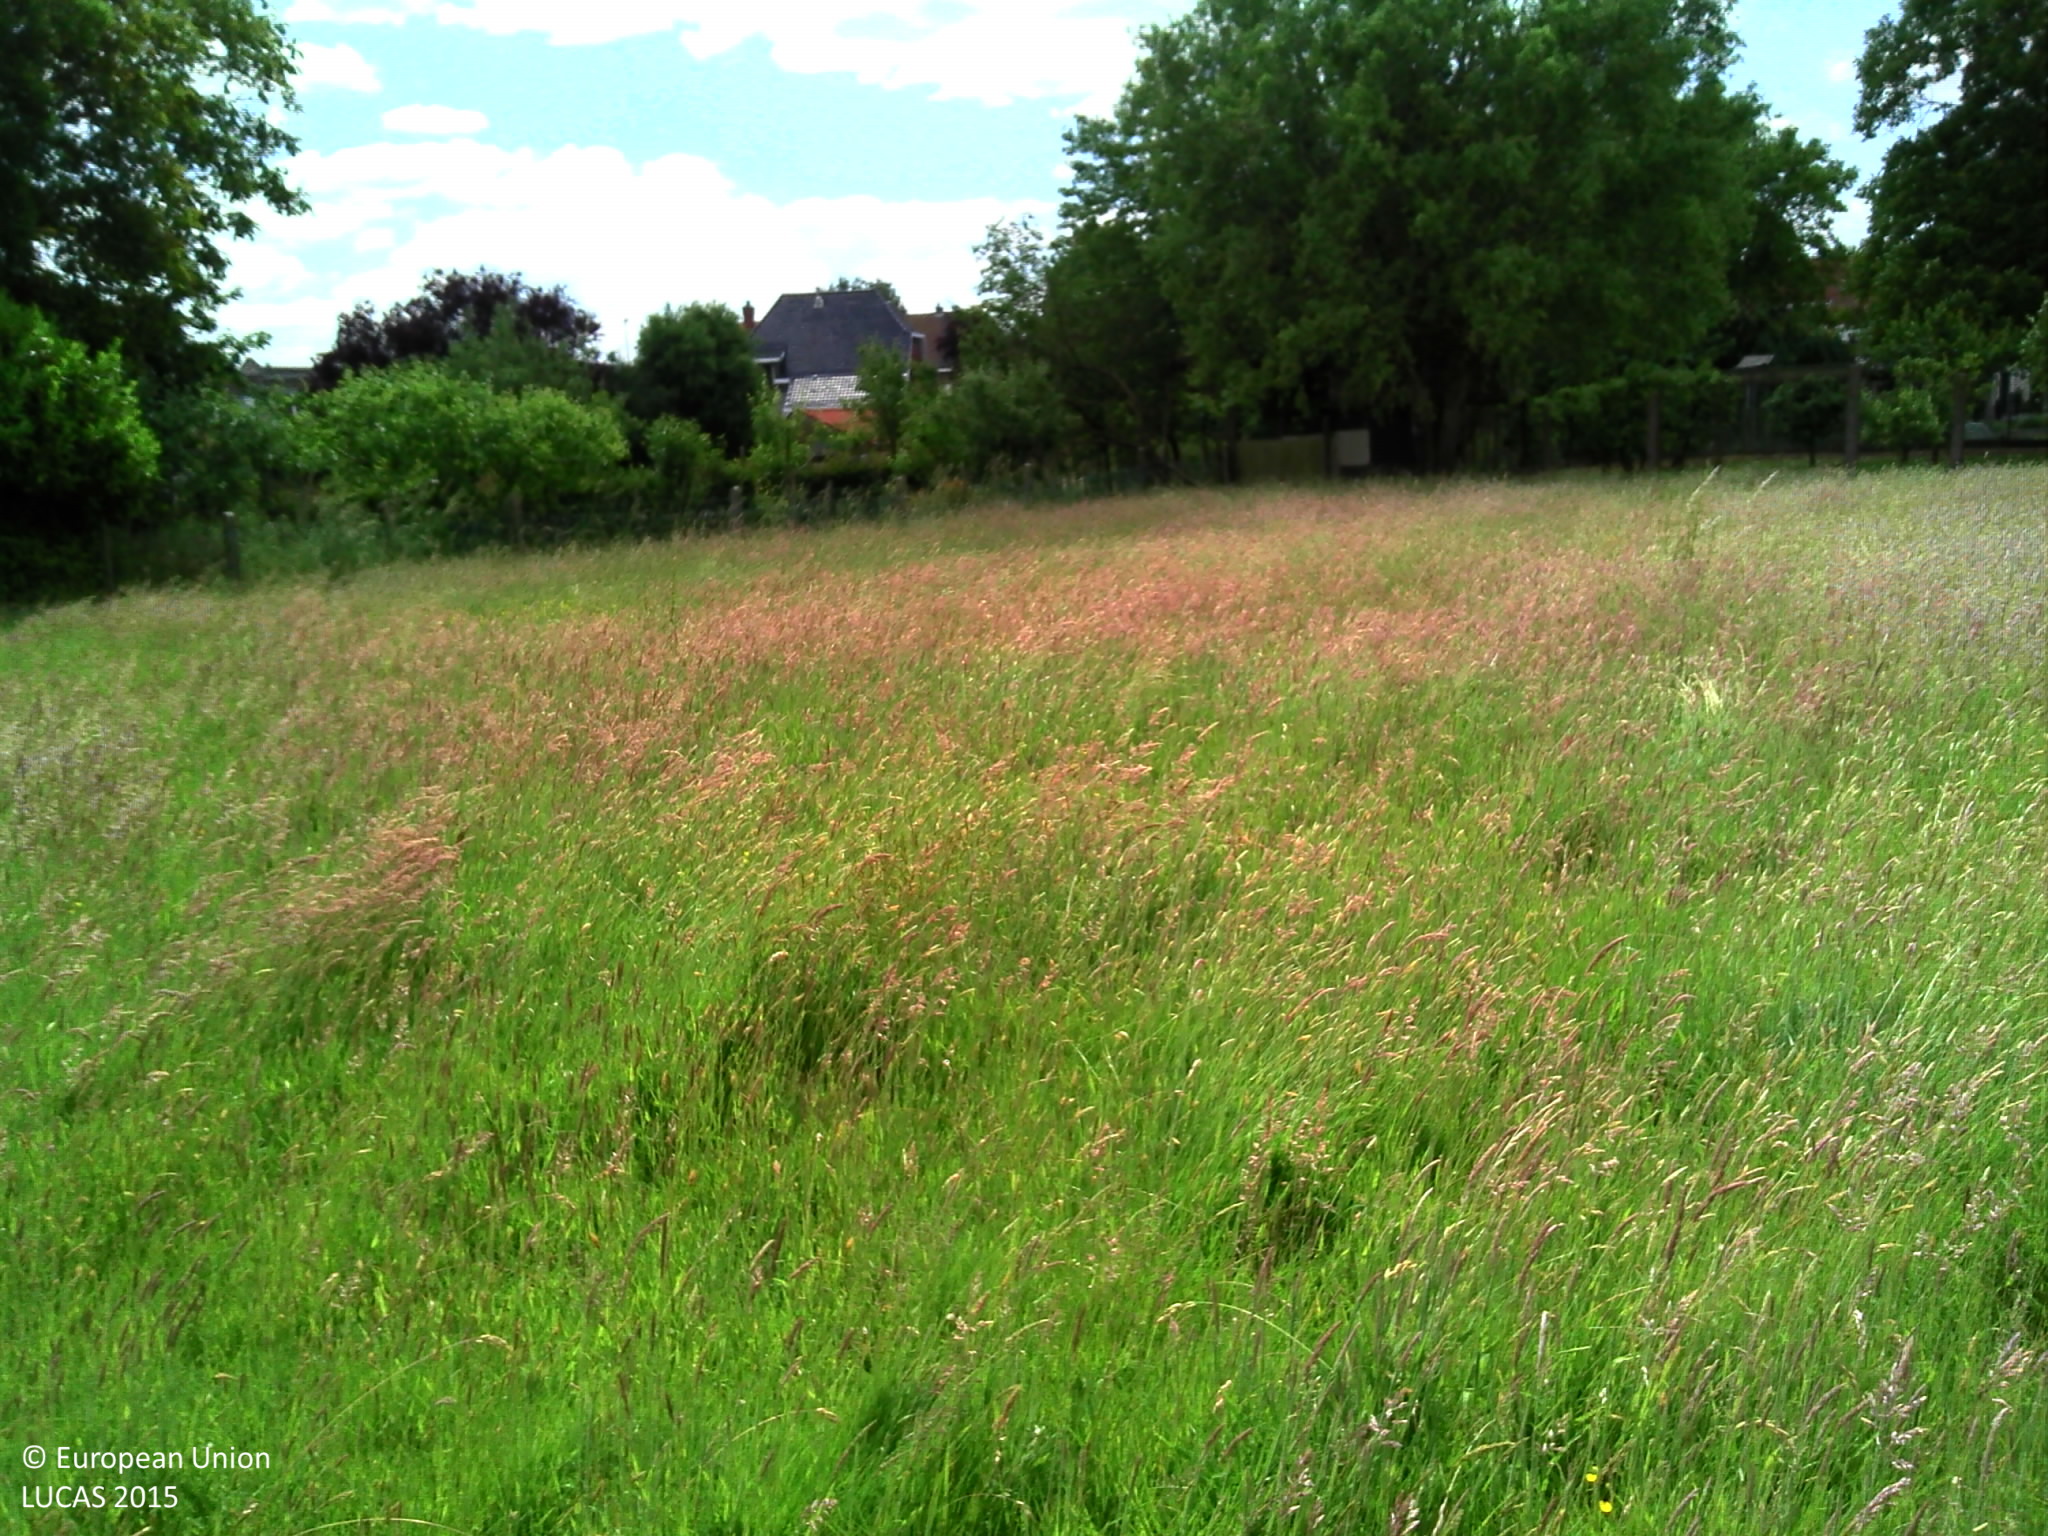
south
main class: Grassland
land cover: Grassland without tree/shrub cover
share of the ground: > 75 %
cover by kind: herbaceous plants 100 %
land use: Residential
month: June
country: BE
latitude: 50.8709
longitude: 3.6123
